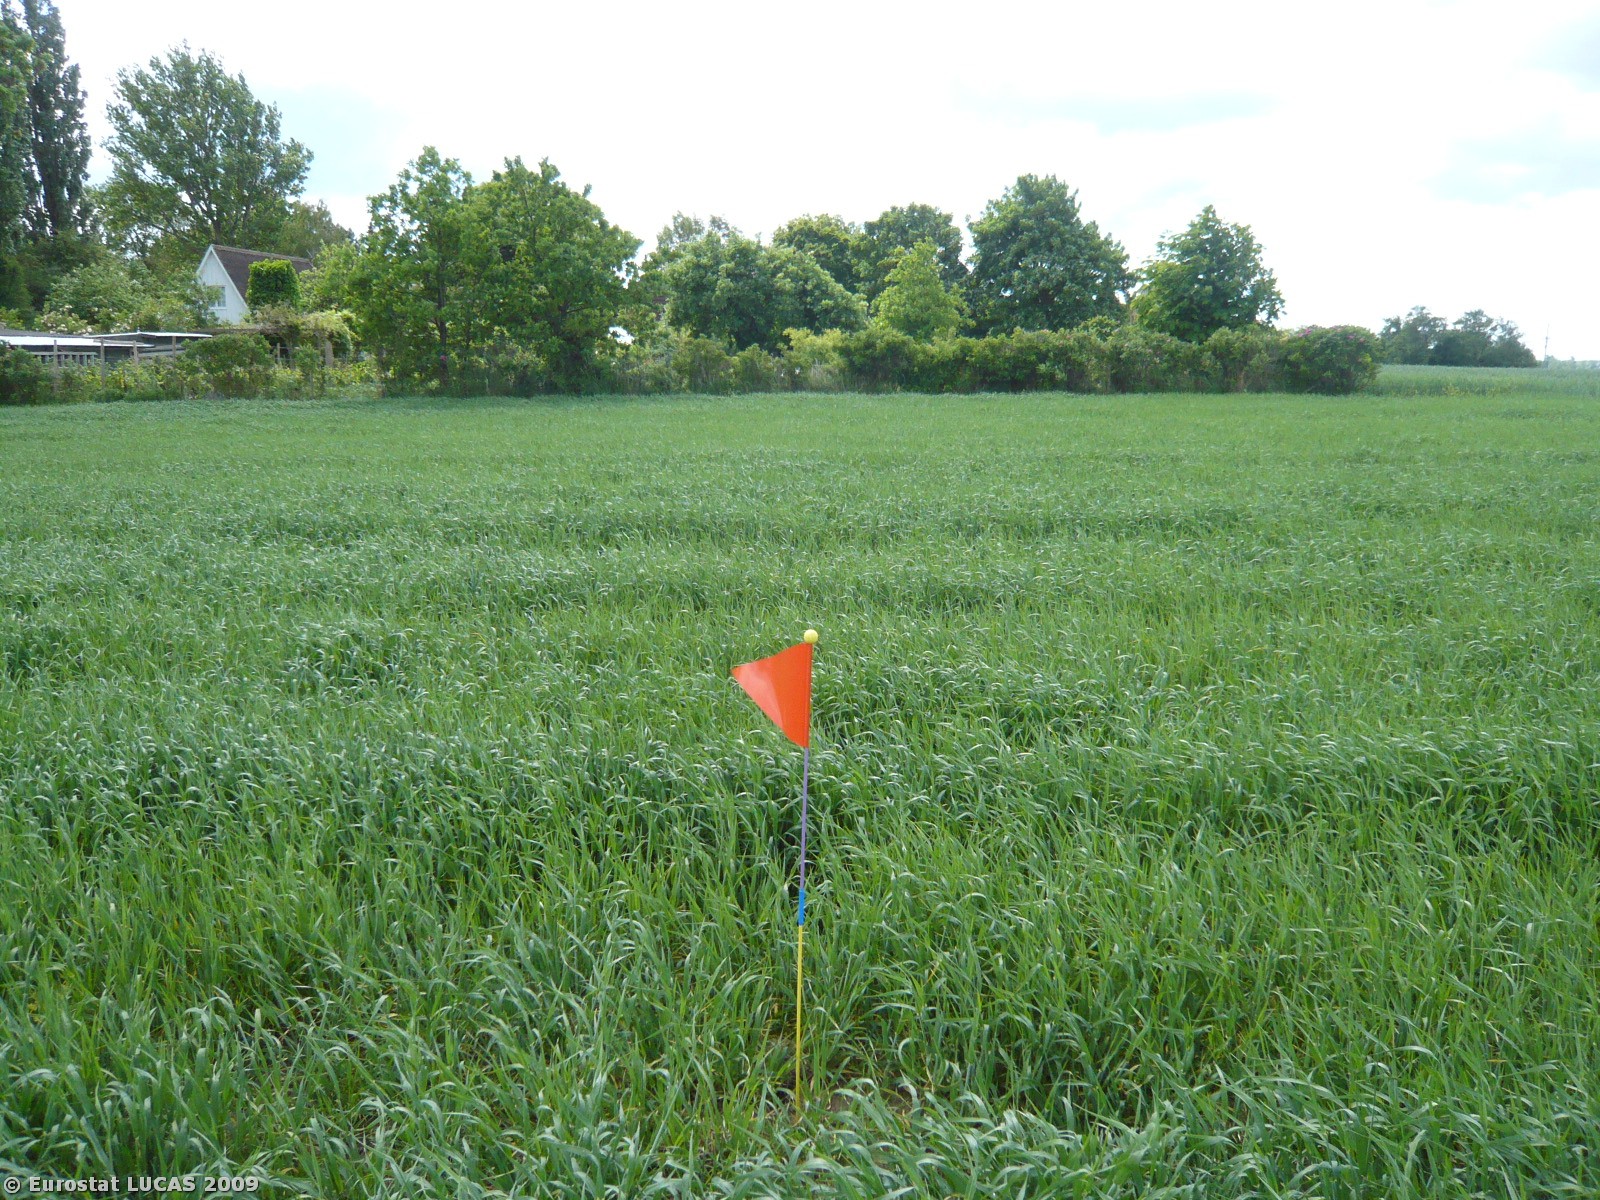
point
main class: Cropland
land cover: Barley
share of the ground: > 75 %
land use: Agriculture (excluding fallow land and kitchen gardens)
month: June
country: DK
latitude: 55.2255
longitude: 11.5552
